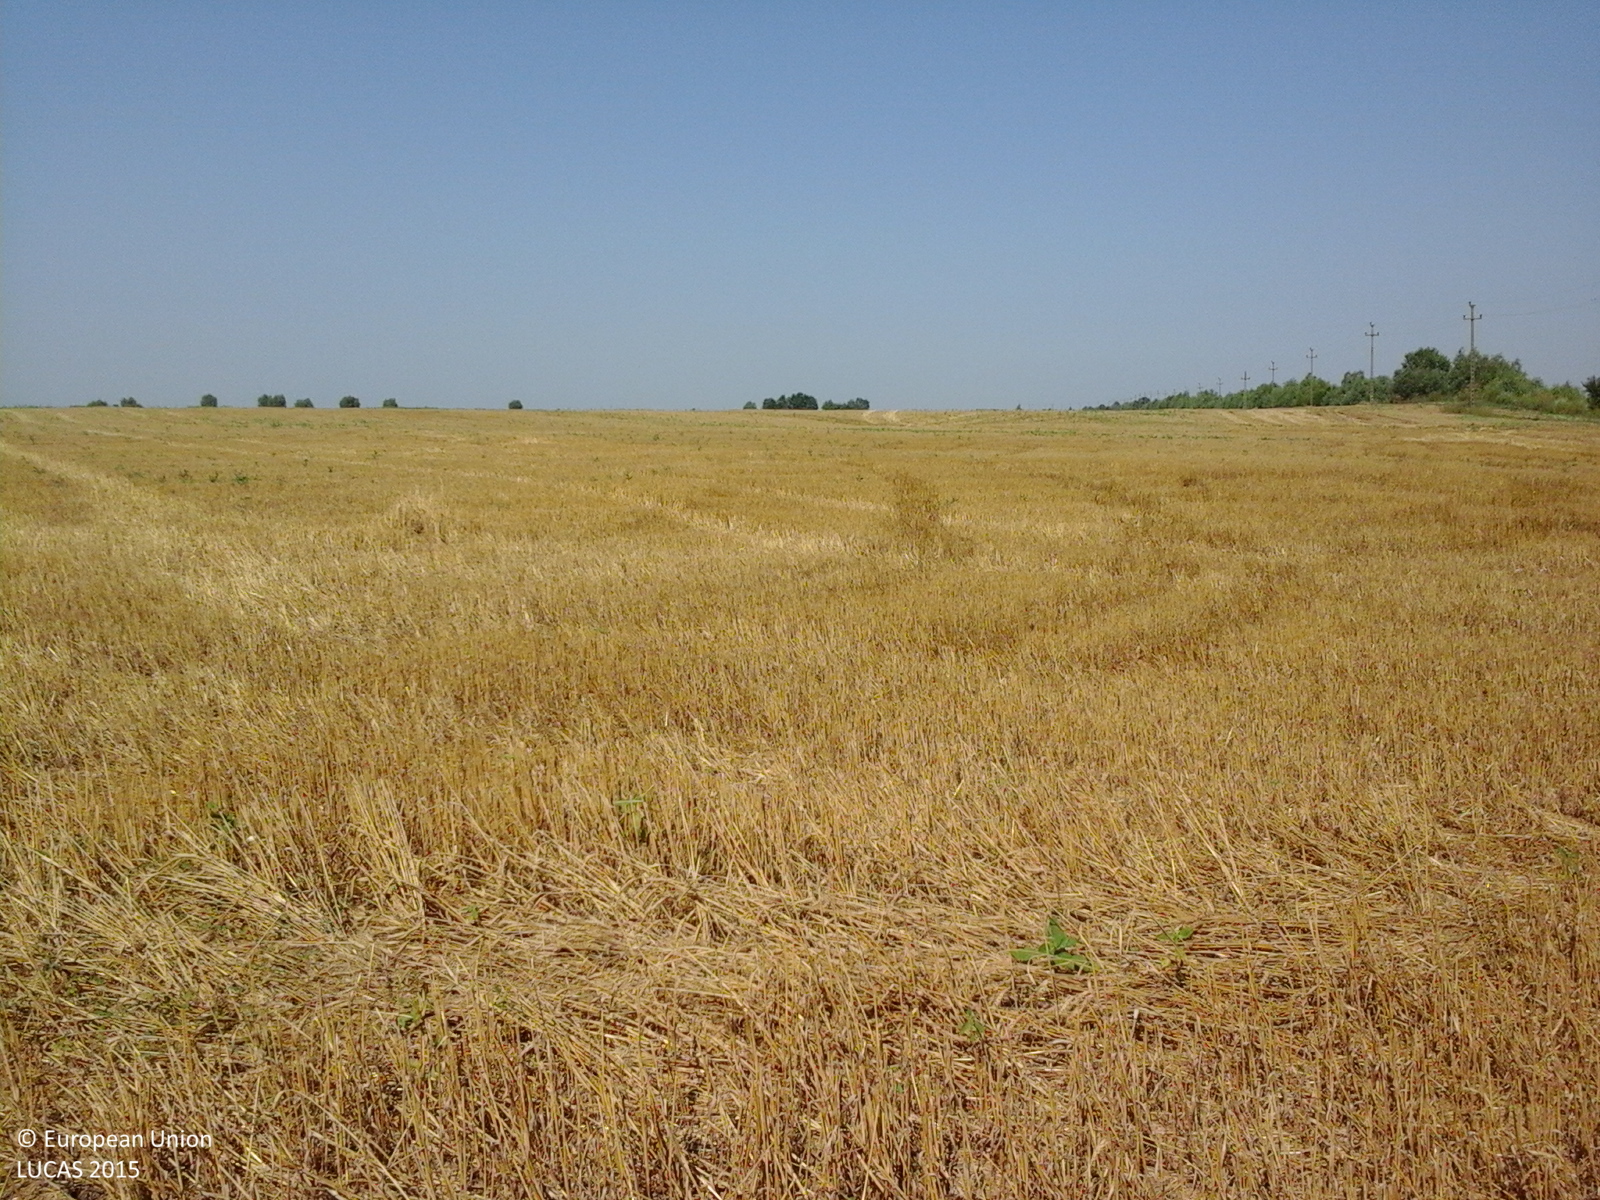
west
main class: Cropland
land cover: Durum wheat
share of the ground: 25 - 50 %
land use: Agriculture (excluding fallow land and kitchen gardens)
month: July
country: RO
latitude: 44.2930
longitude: 27.8858
